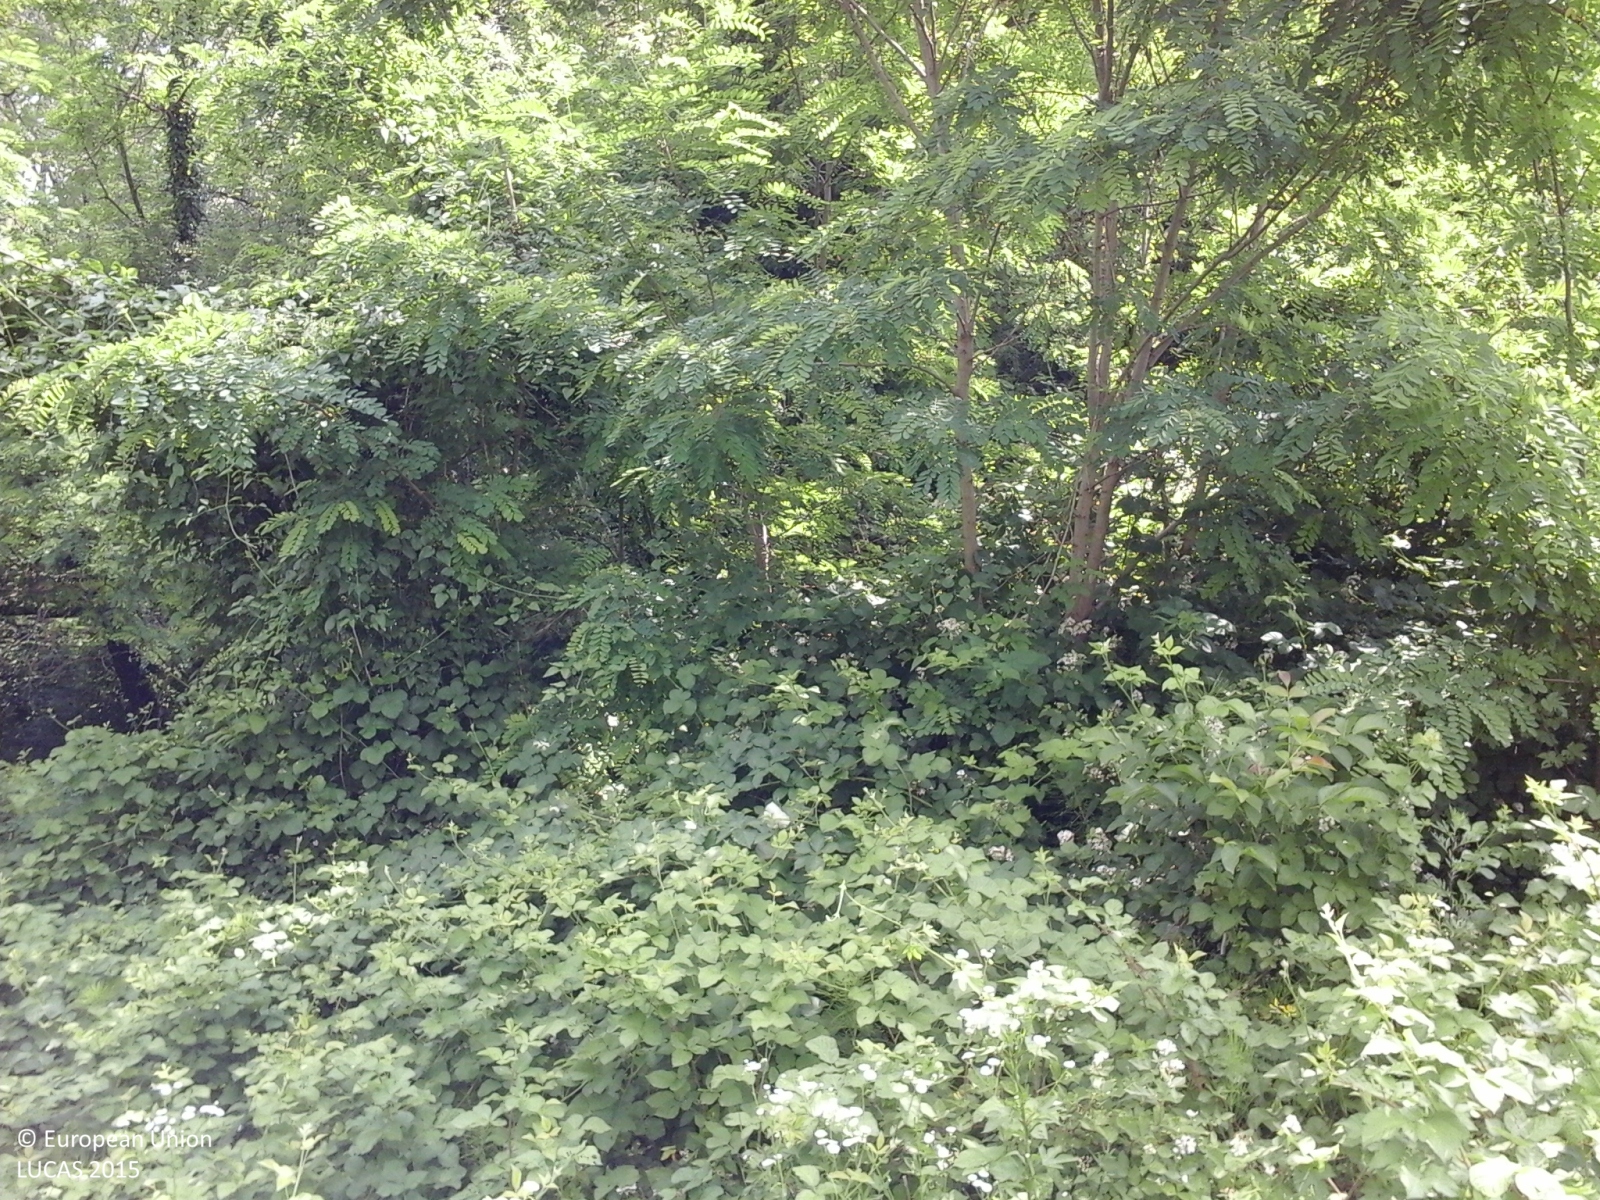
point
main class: Shrubland
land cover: Shrubland with sparse tree cover
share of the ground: > 75 %
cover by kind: shrubs 95 %, broadleaved forest trees 5 %
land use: Semi-natural and natural areas not in use
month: June
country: IT
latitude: 44.8550
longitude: 9.6843
